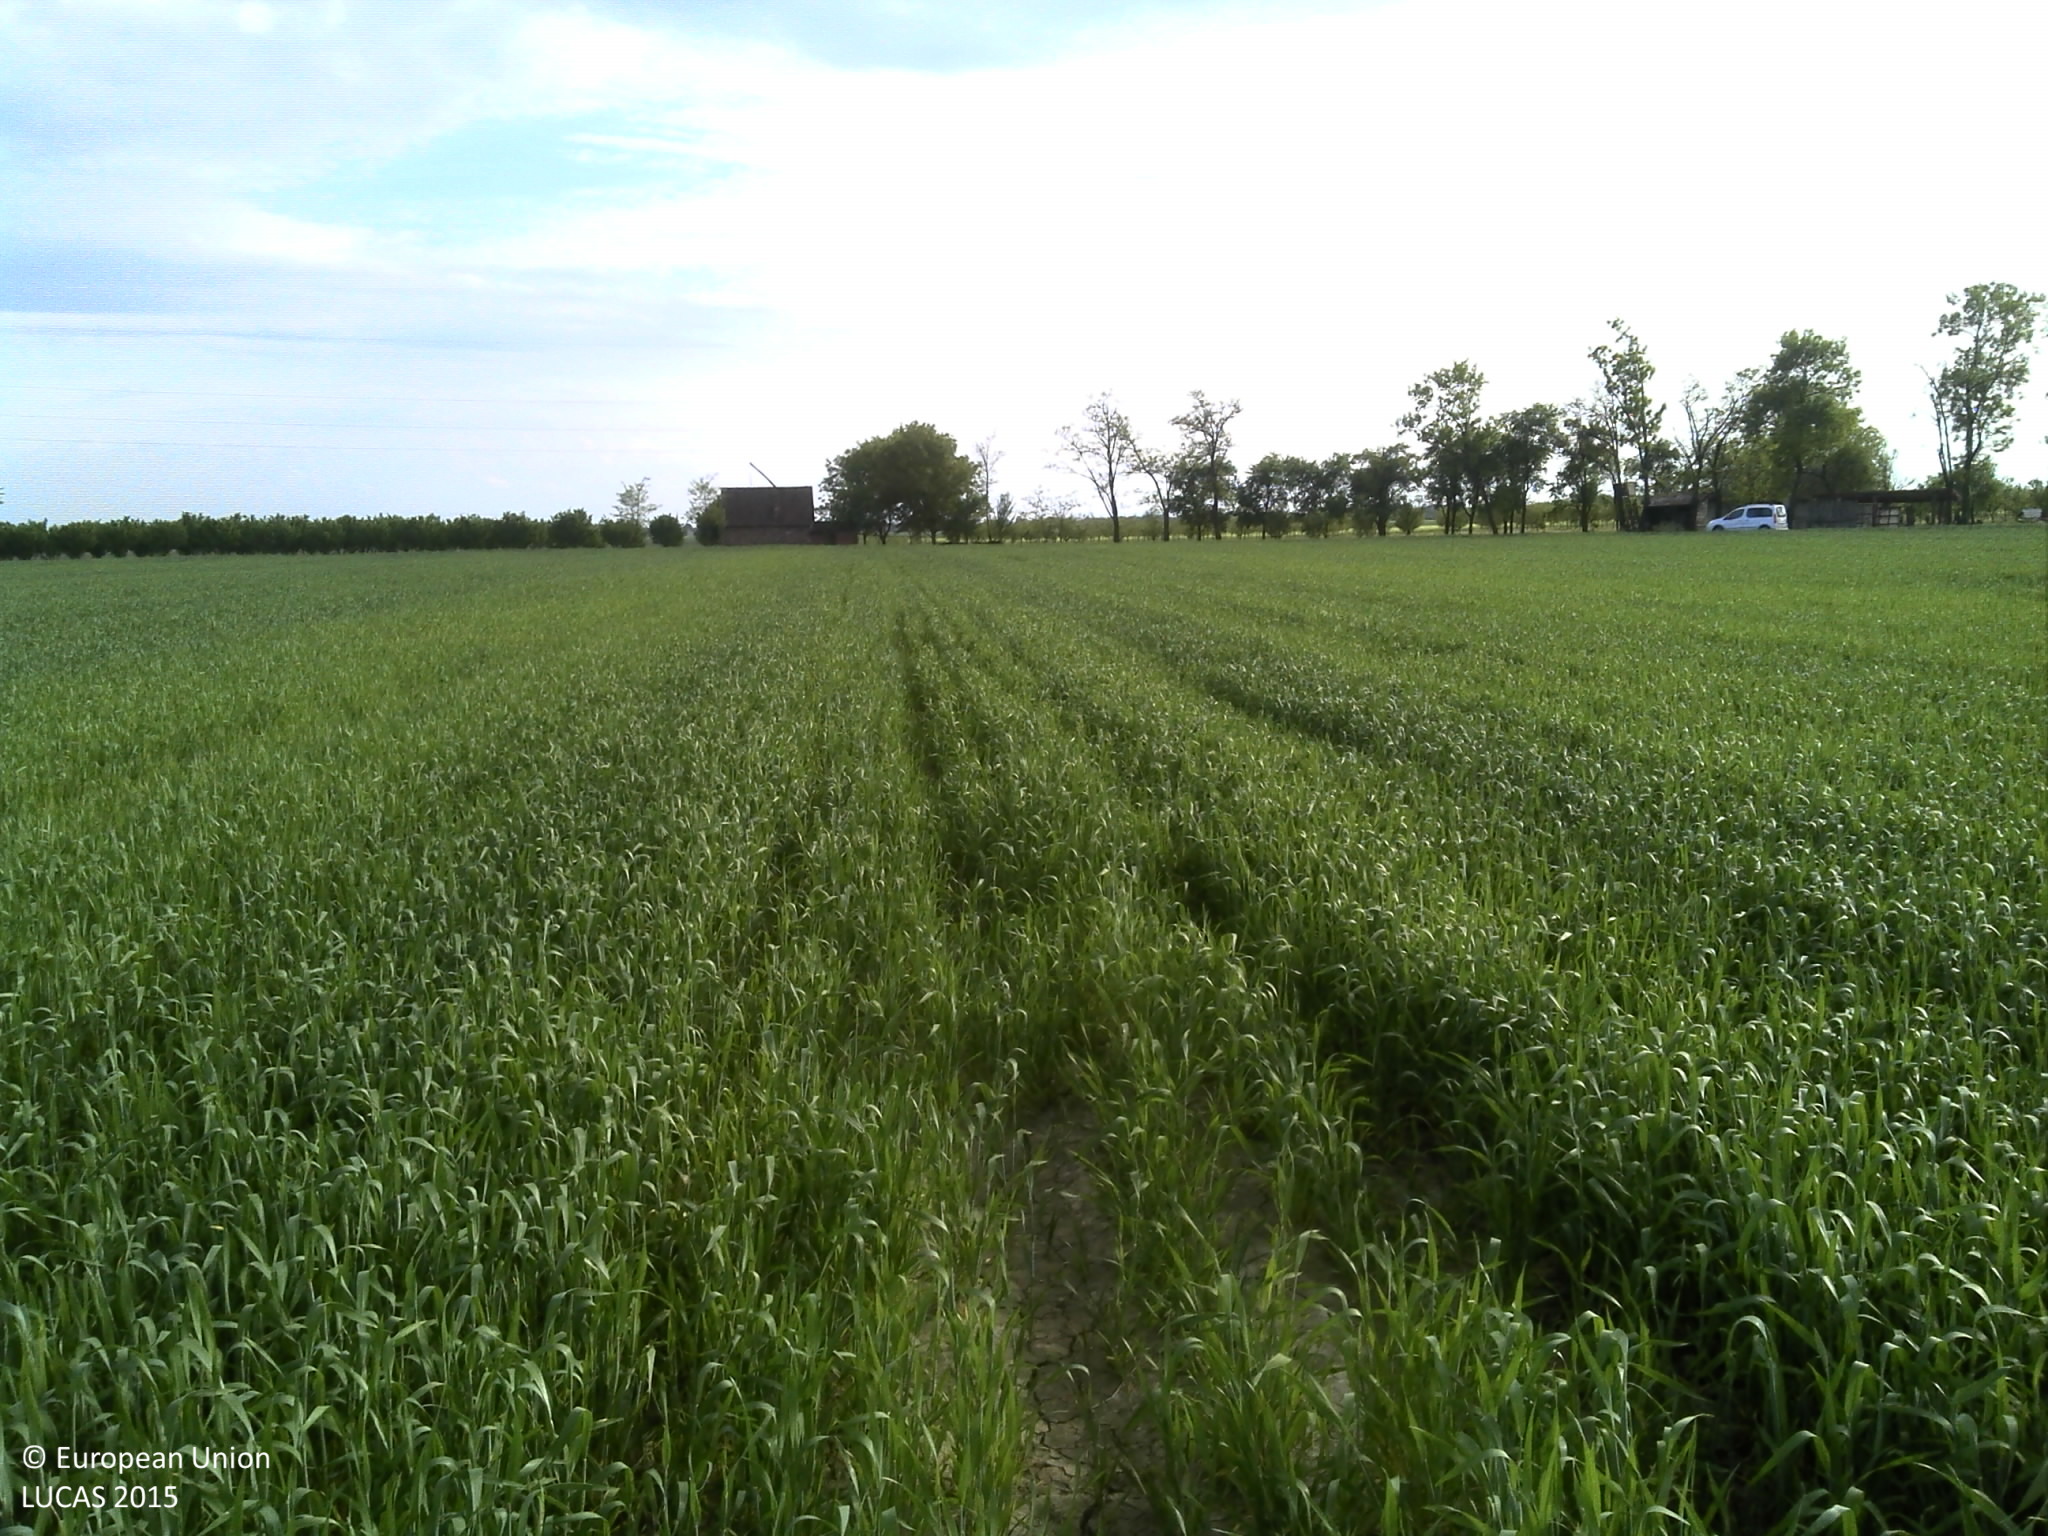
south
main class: Cropland
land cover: Common wheat
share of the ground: > 75 %
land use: Agriculture (excluding fallow land and kitchen gardens)
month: May
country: HR
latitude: 45.1642
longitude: 18.9001
